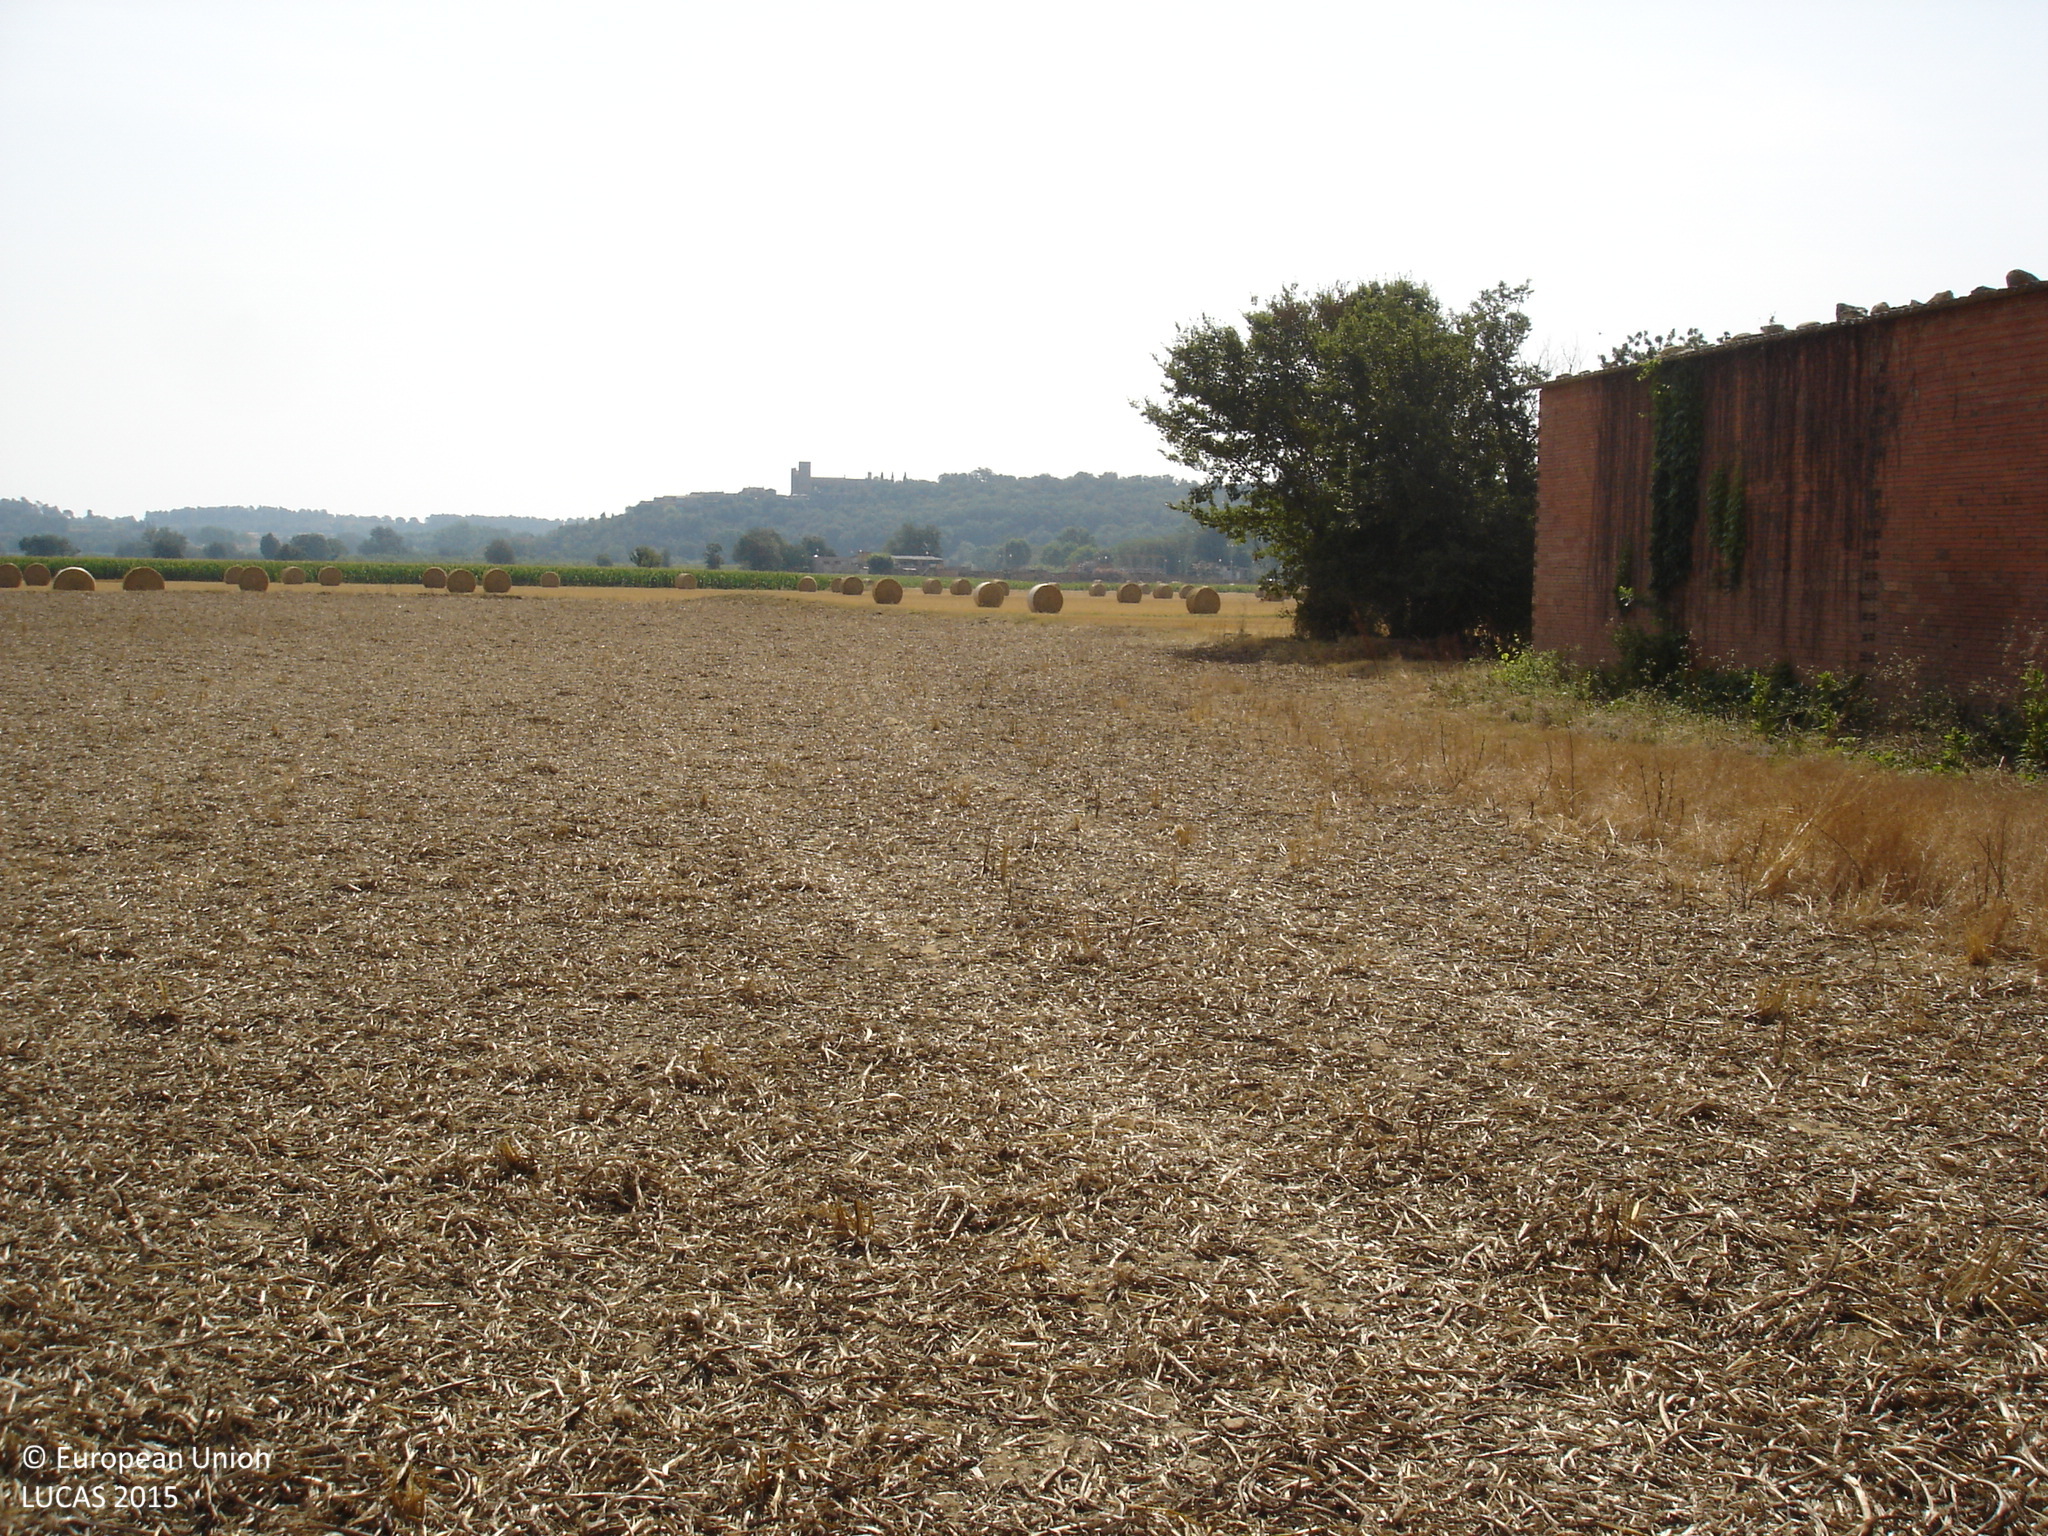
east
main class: Cropland
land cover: Rape and turnip rape
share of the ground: < 10 %
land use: Agriculture (excluding fallow land and kitchen gardens)
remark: Harvested field
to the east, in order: Rape and turnip rape; Grass margins; Tracks; Grass margins; Common wheat
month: July
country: ES
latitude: 41.9786
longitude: 3.0280
